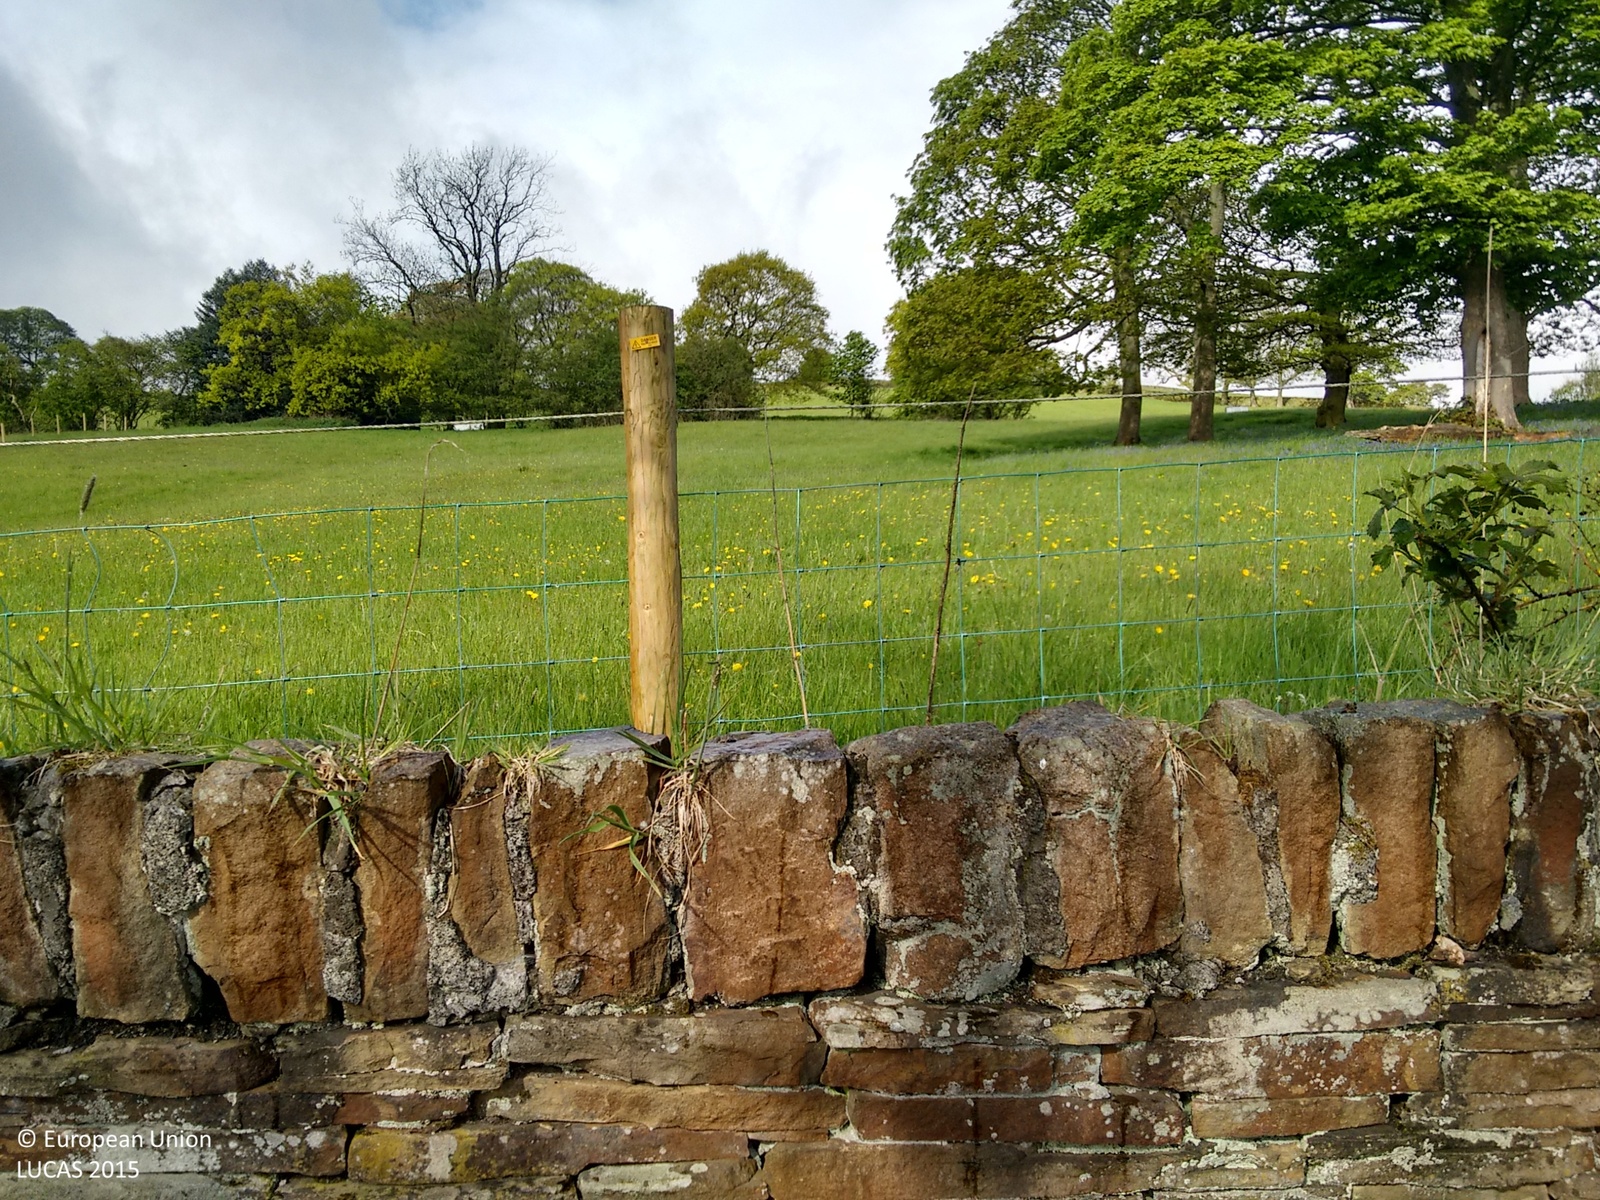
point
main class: Grassland
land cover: Grassland without tree/shrub cover
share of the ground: > 75 %
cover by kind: herbaceous plants 100 %
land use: Agriculture (excluding fallow land and kitchen gardens)
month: May
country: GB
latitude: 53.6696
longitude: -1.8765
